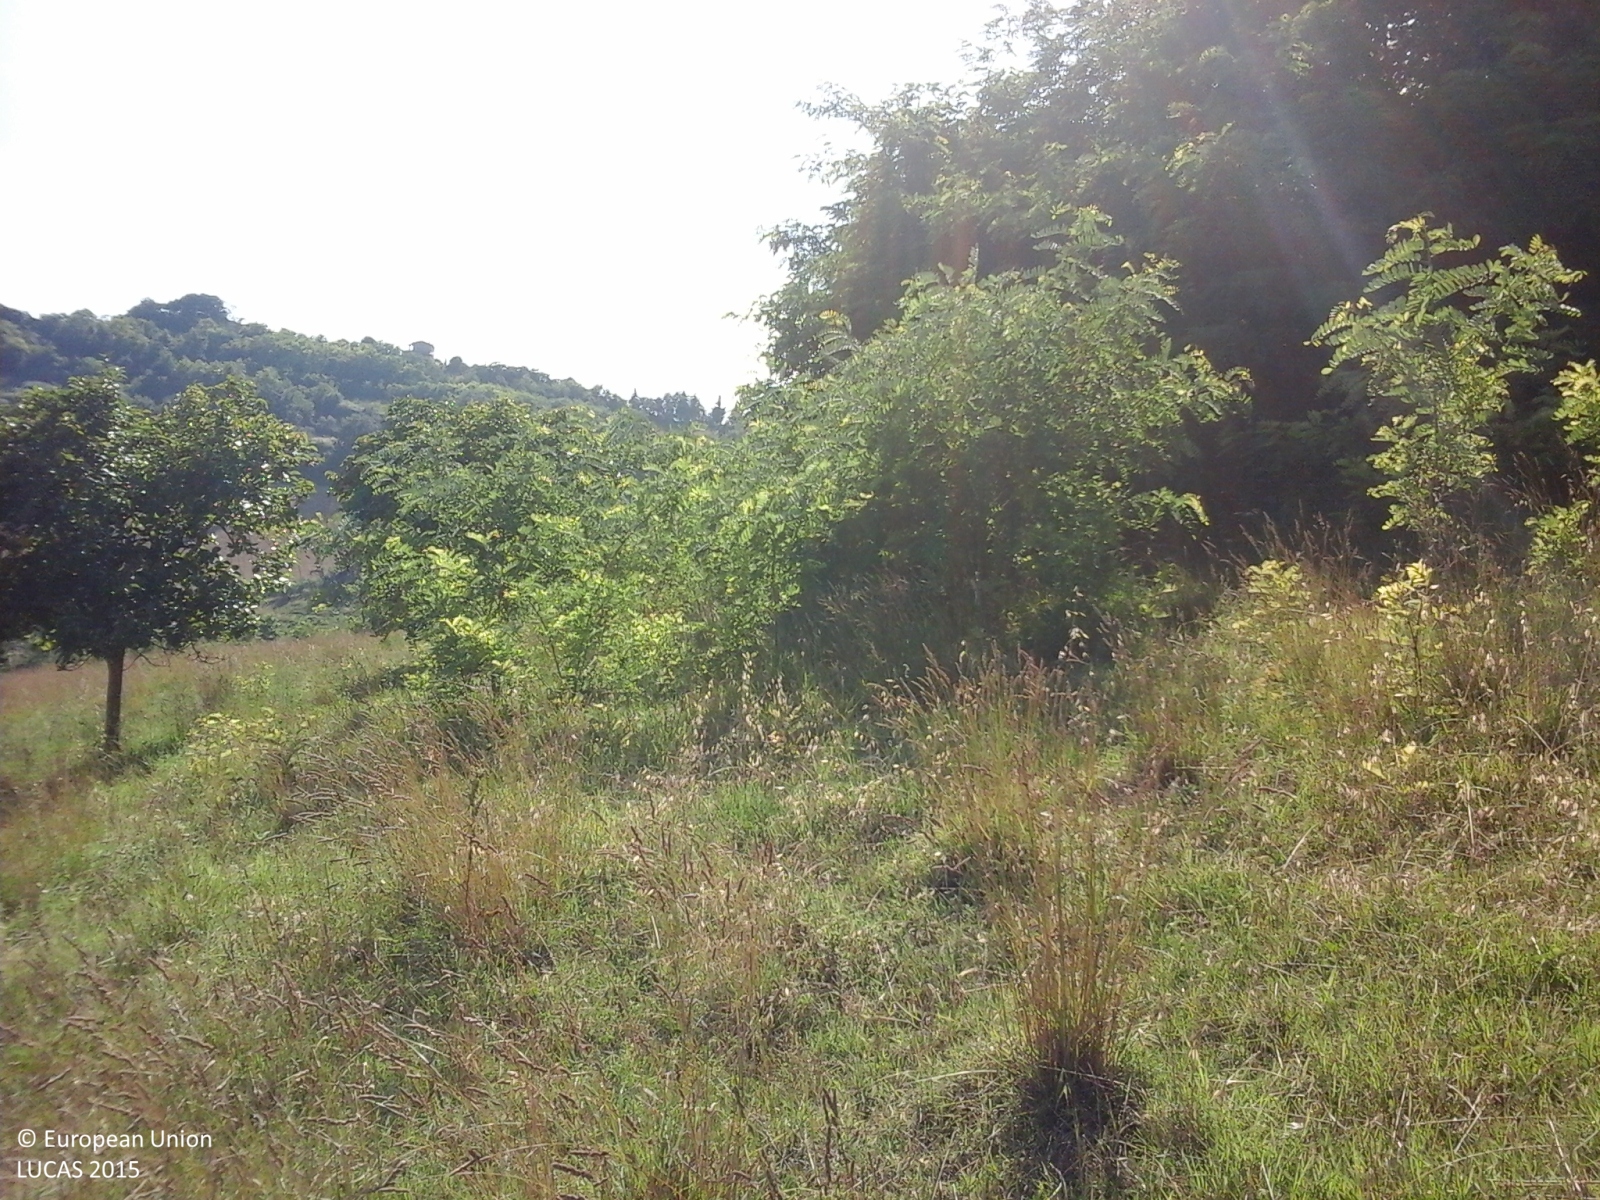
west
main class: Grassland
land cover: Grassland without tree/shrub cover
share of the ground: > 75 %
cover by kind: herbaceous plants 100 %
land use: Agriculture (excluding fallow land and kitchen gardens)
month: June
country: IT
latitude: 42.9082
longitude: 13.7989
